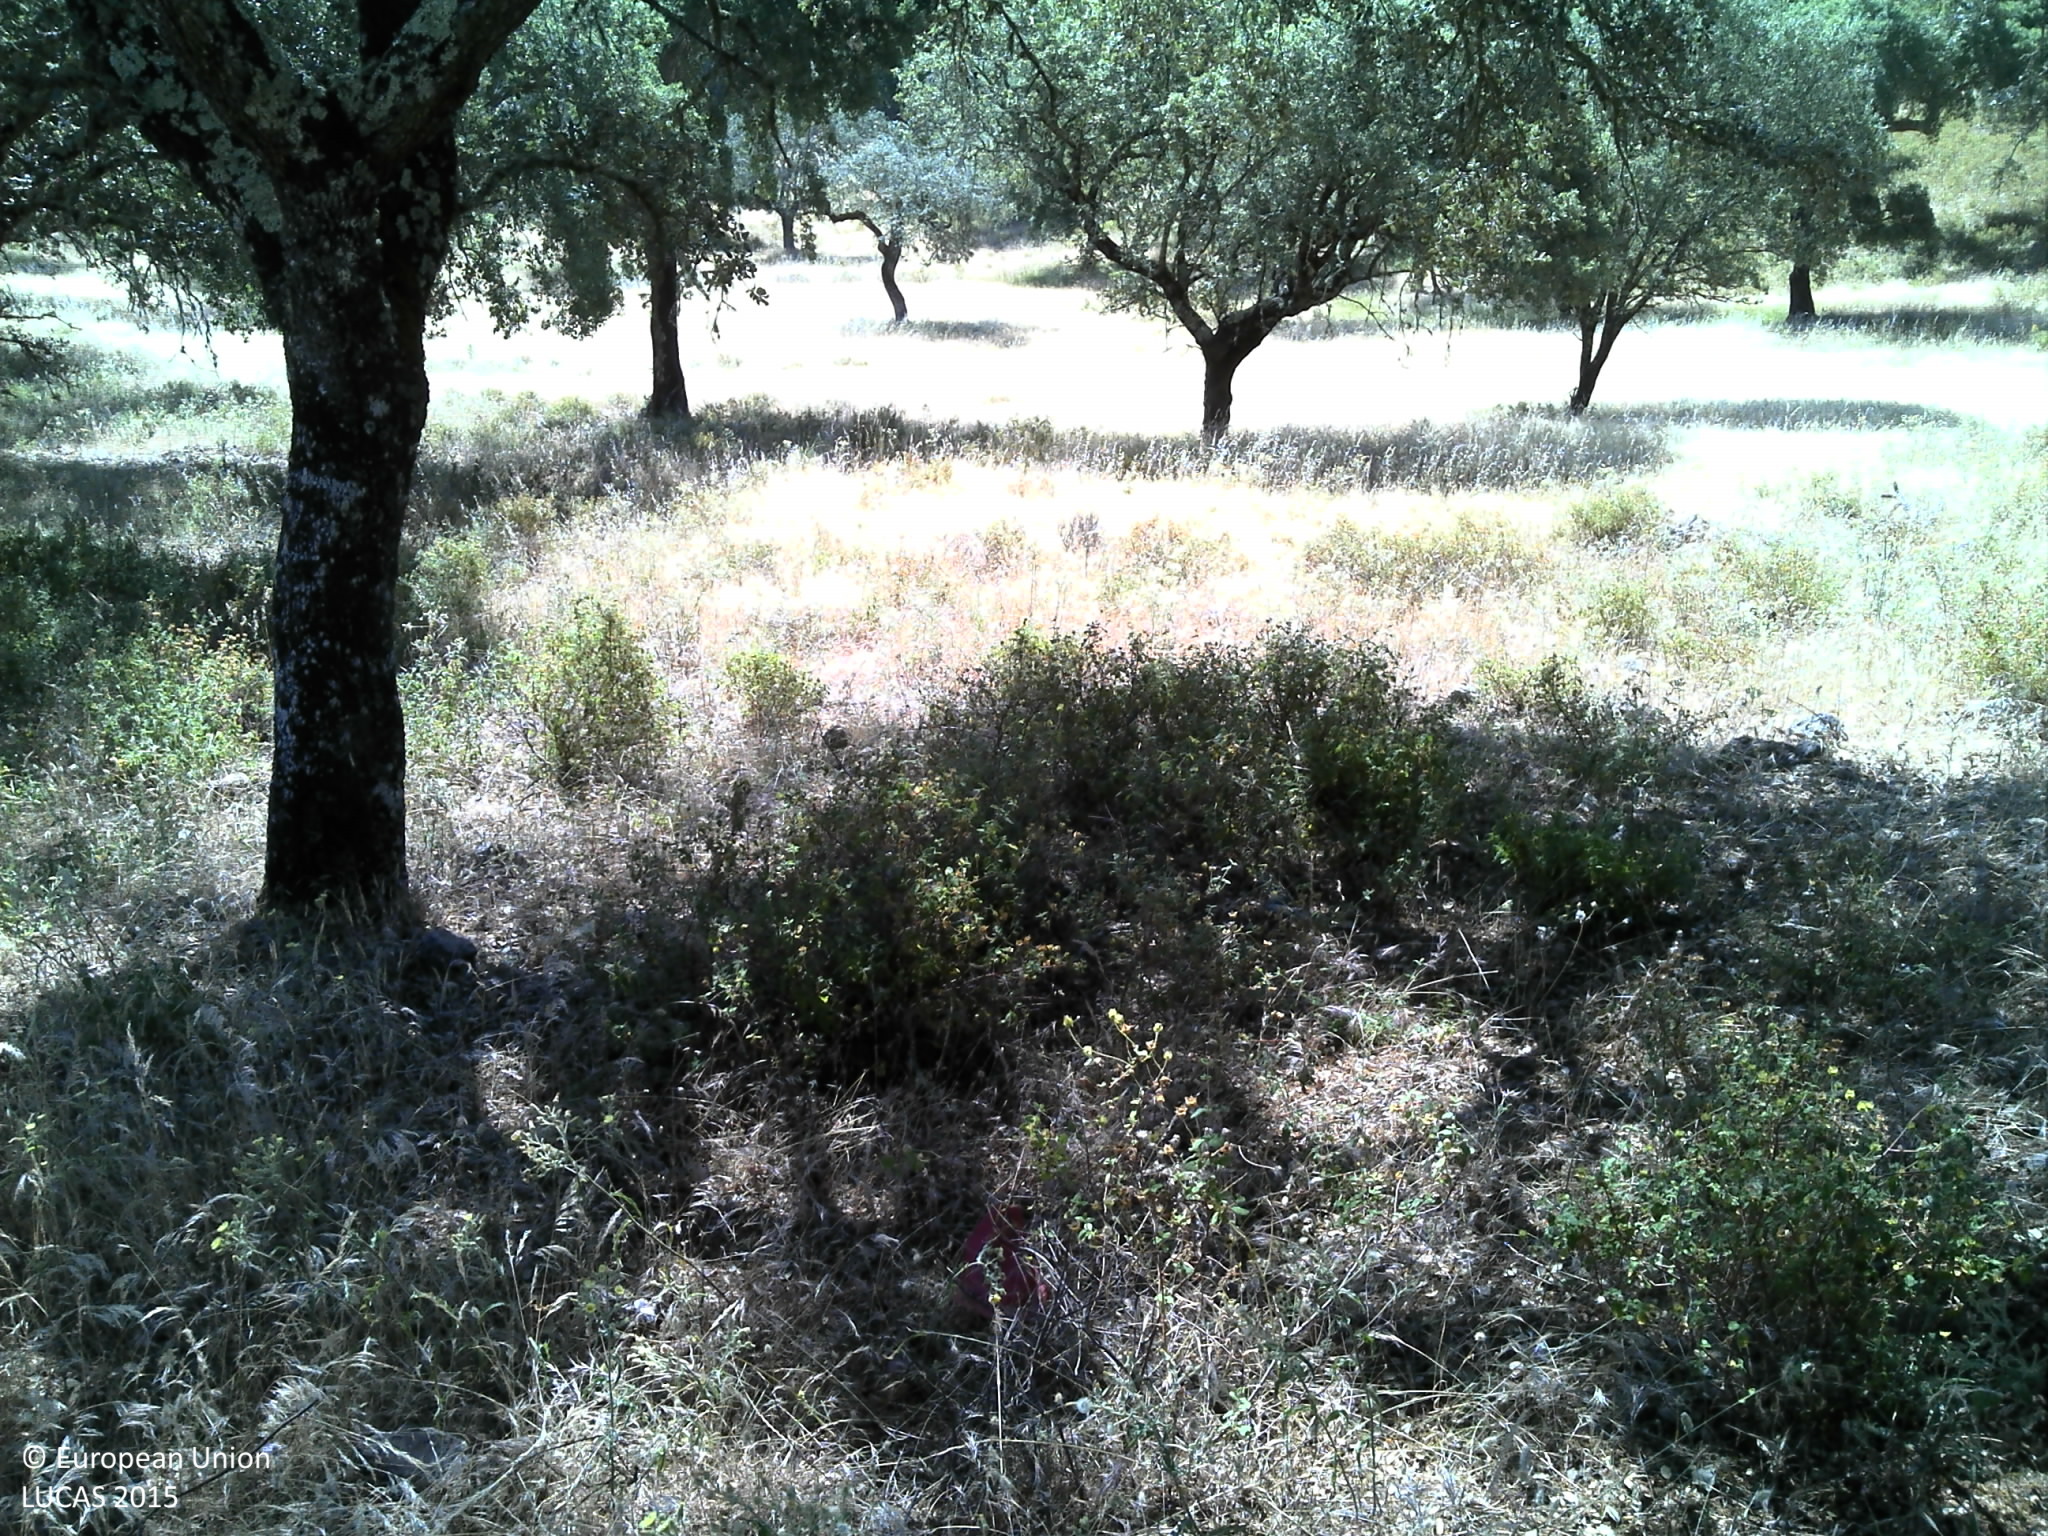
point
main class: Woodland
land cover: Broadleaved woodland
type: broadleaved evergreen forest
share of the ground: 50 - 75 %
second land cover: Grassland without tree/shrub cover
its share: 25 - 50 %
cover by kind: broadleaved forest trees 50 %, herbaceous plants 40 %, unconsolidated bare surface 10 %
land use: Forestry
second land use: Agriculture (excluding fallow land and kitchen gardens)
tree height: > 5 m
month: June
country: PT
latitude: 38.7790
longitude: -8.1564
